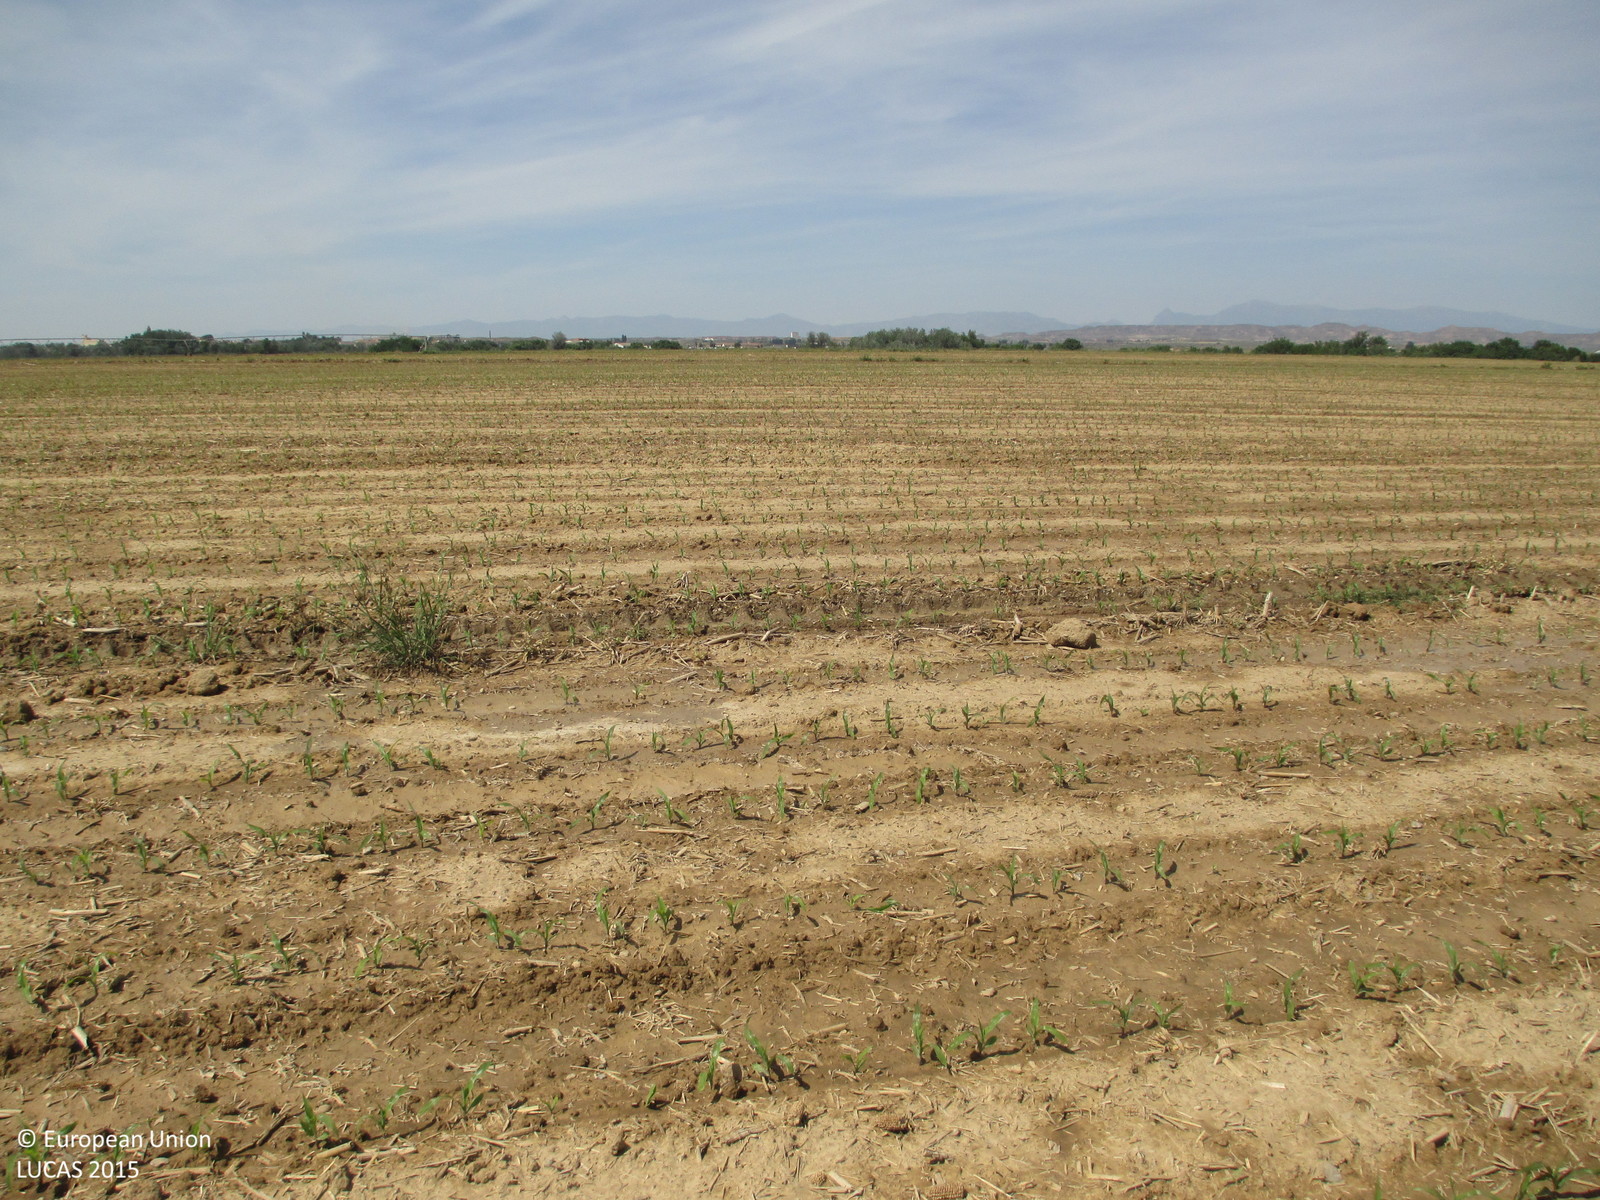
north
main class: Cropland
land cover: Maize
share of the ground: 10 - 25 %
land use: Agriculture (excluding fallow land and kitchen gardens)
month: May
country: ES
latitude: 41.9218
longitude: -0.3541
